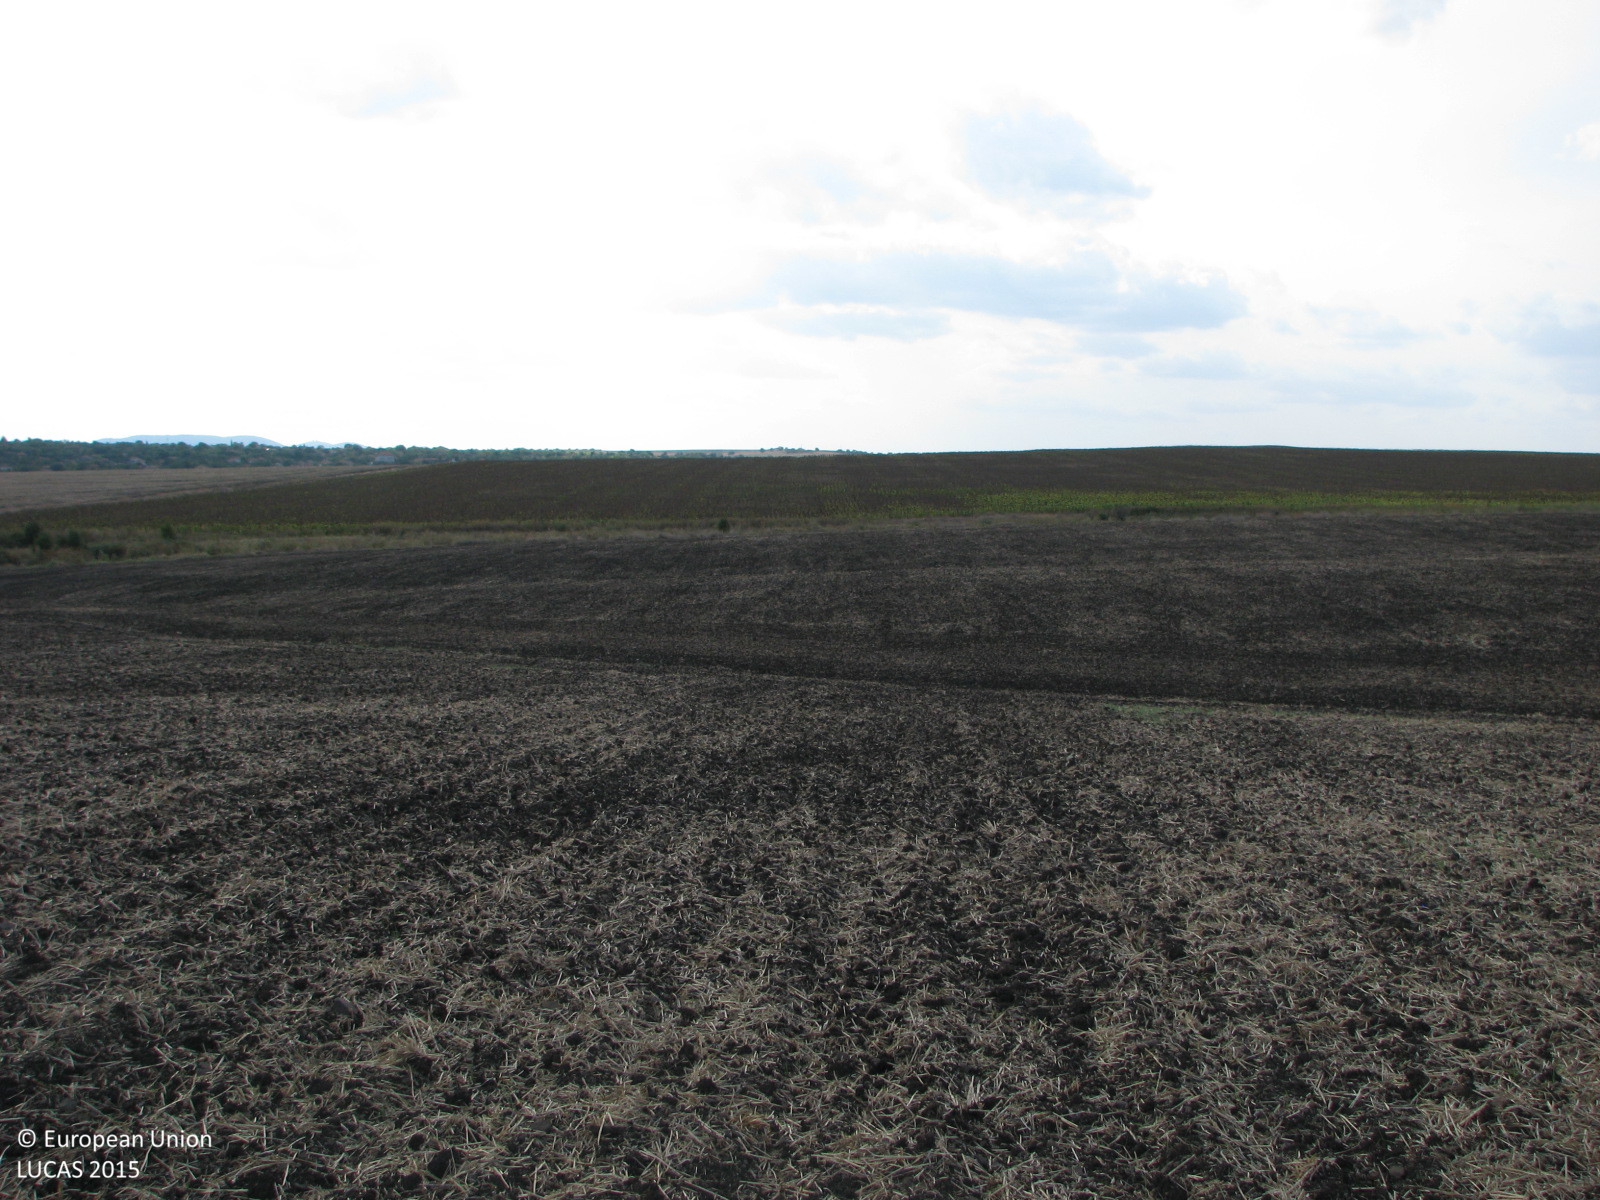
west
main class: Cropland
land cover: Common wheat
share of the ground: < 10 %
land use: Agriculture (excluding fallow land and kitchen gardens)
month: September
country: BG
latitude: 42.4642
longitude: 26.8468
